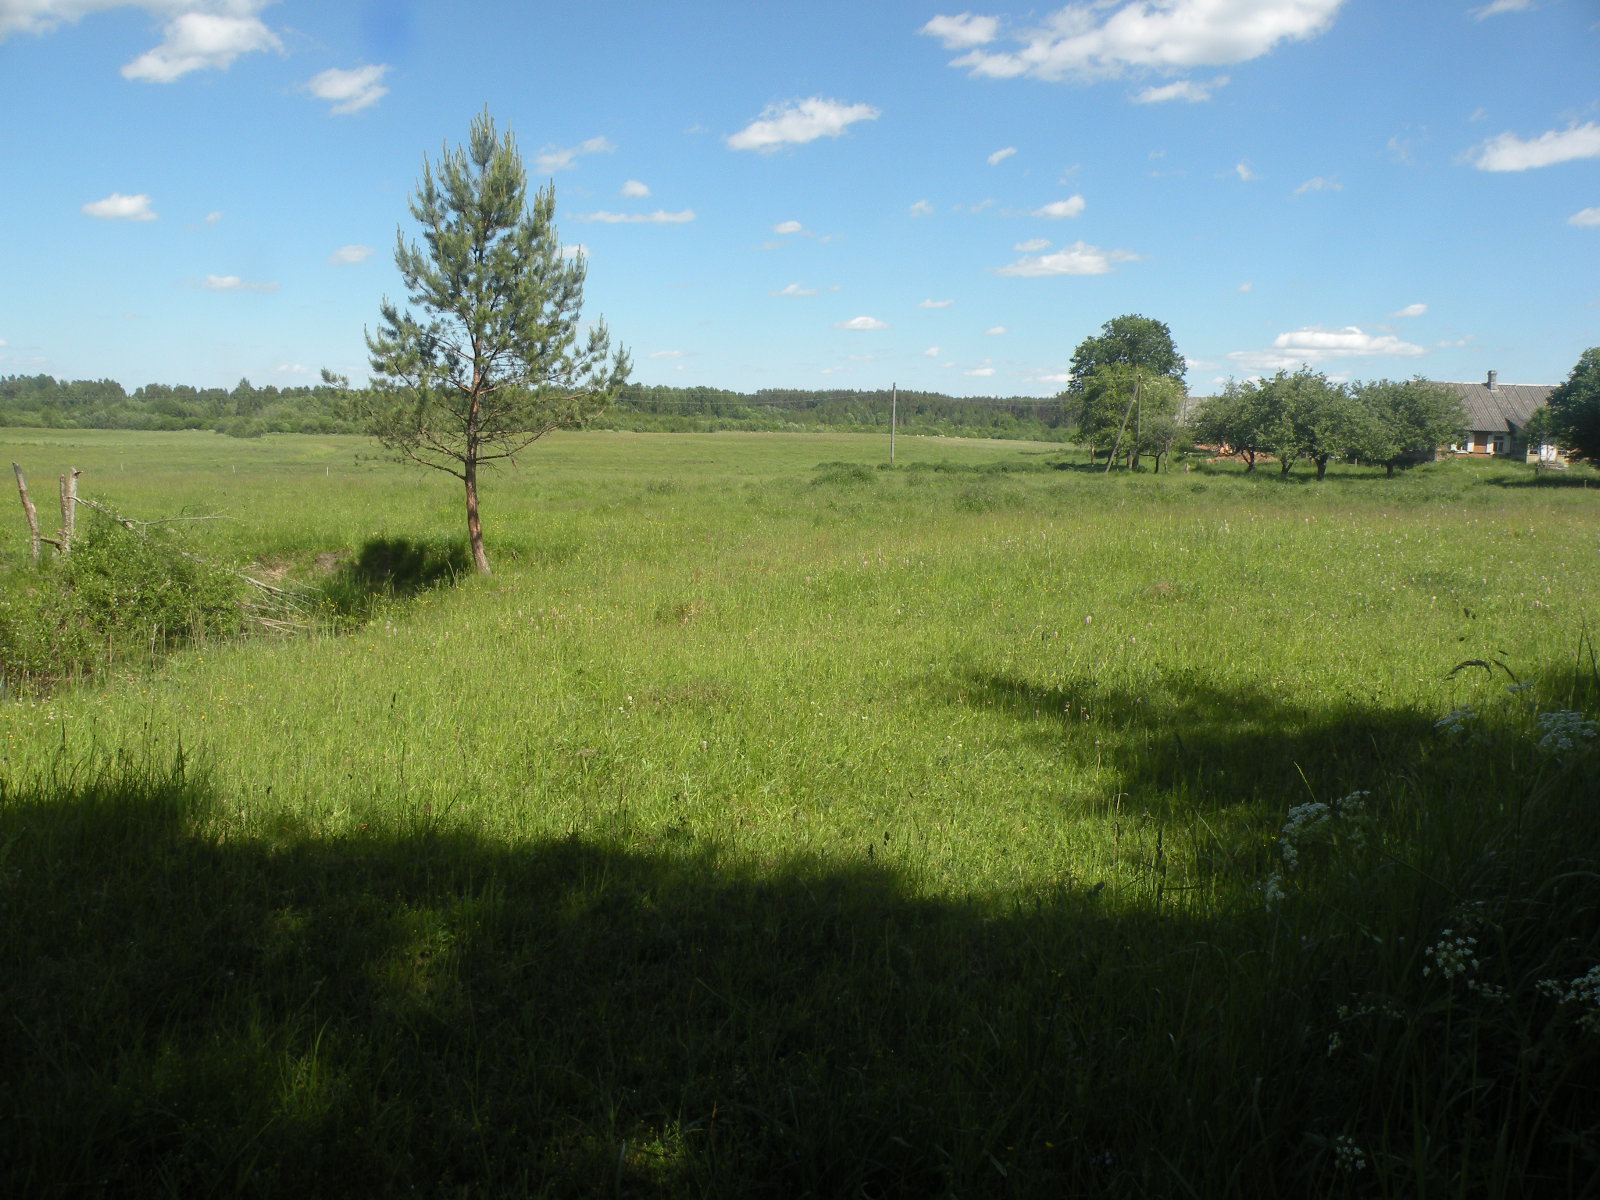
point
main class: Grassland
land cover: Grassland without tree/shrub cover
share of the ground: > 75 %
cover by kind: herbaceous plants 100 %
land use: Agriculture (excluding fallow land and kitchen gardens)
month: June
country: LV
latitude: 55.9311
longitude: 26.9548
